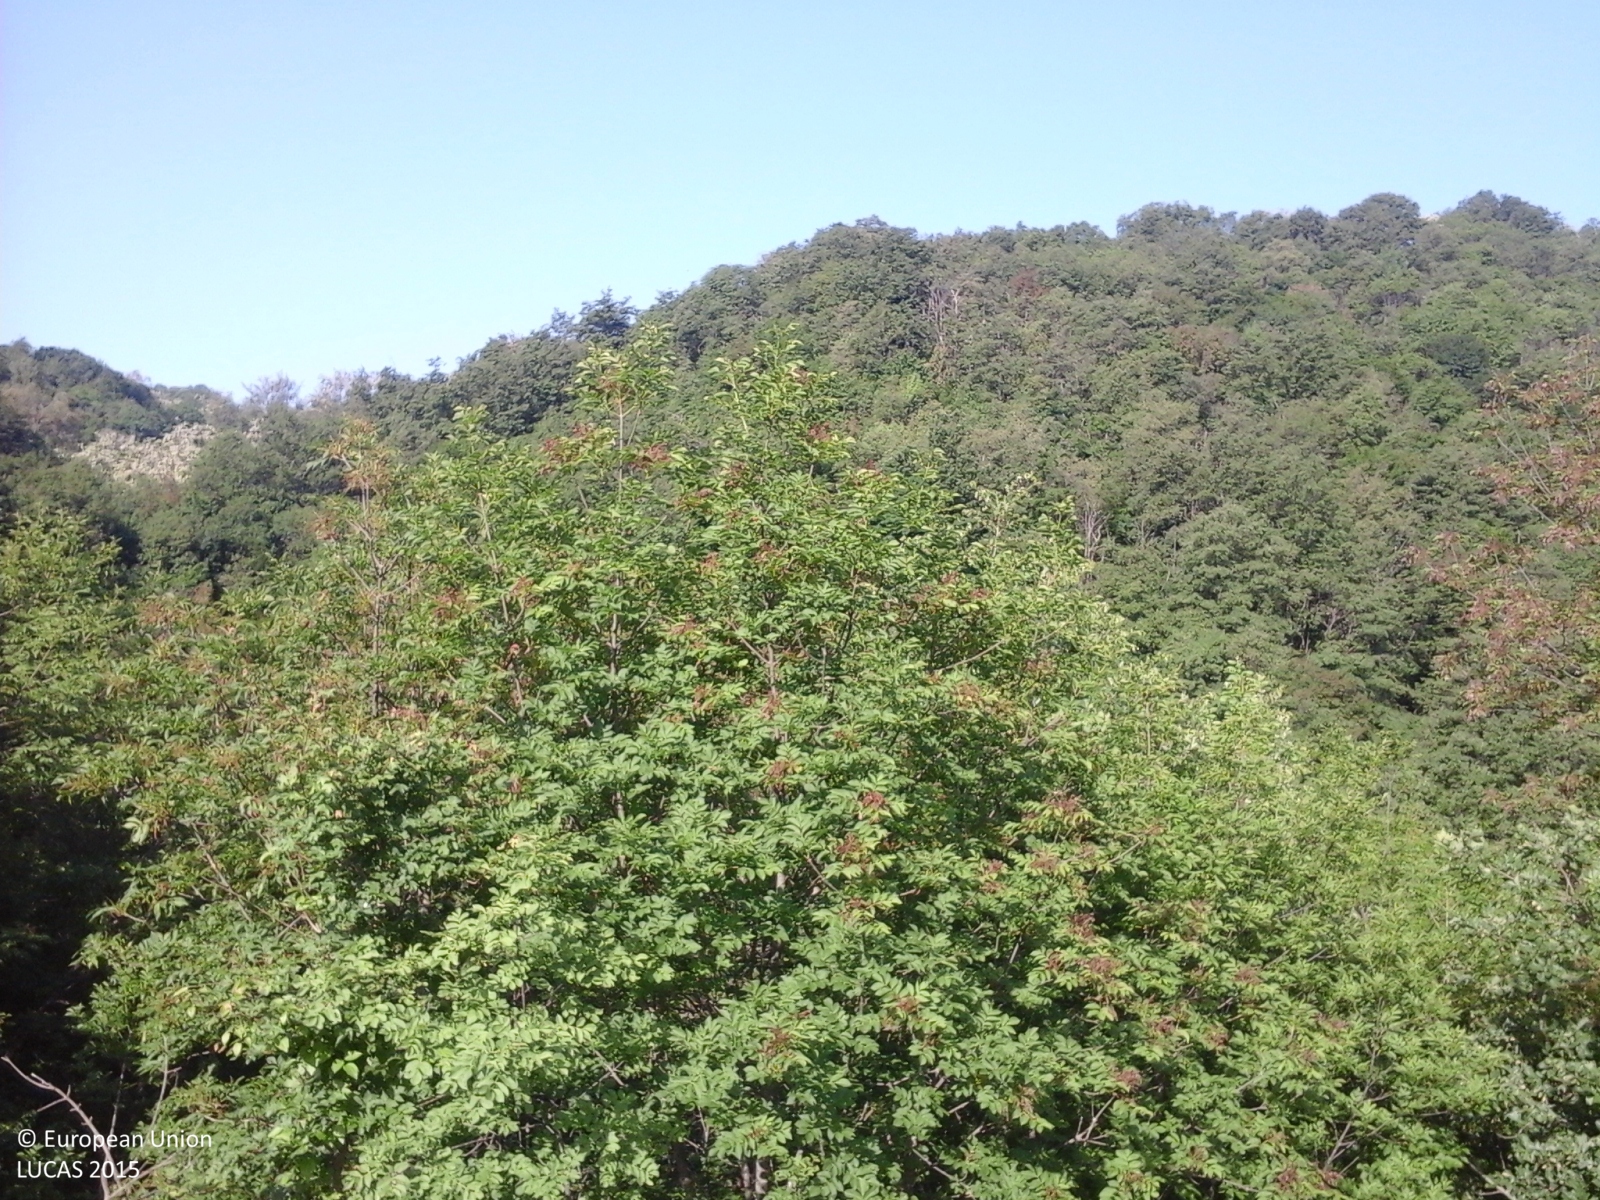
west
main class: Woodland
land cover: Broadleaved woodland
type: mesophytic deciduous forest
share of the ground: > 75 %
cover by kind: broadleaved forest trees 100 %
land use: Forestry
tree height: > 5 m
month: May
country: IT
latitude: 44.4371
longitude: 10.8649
